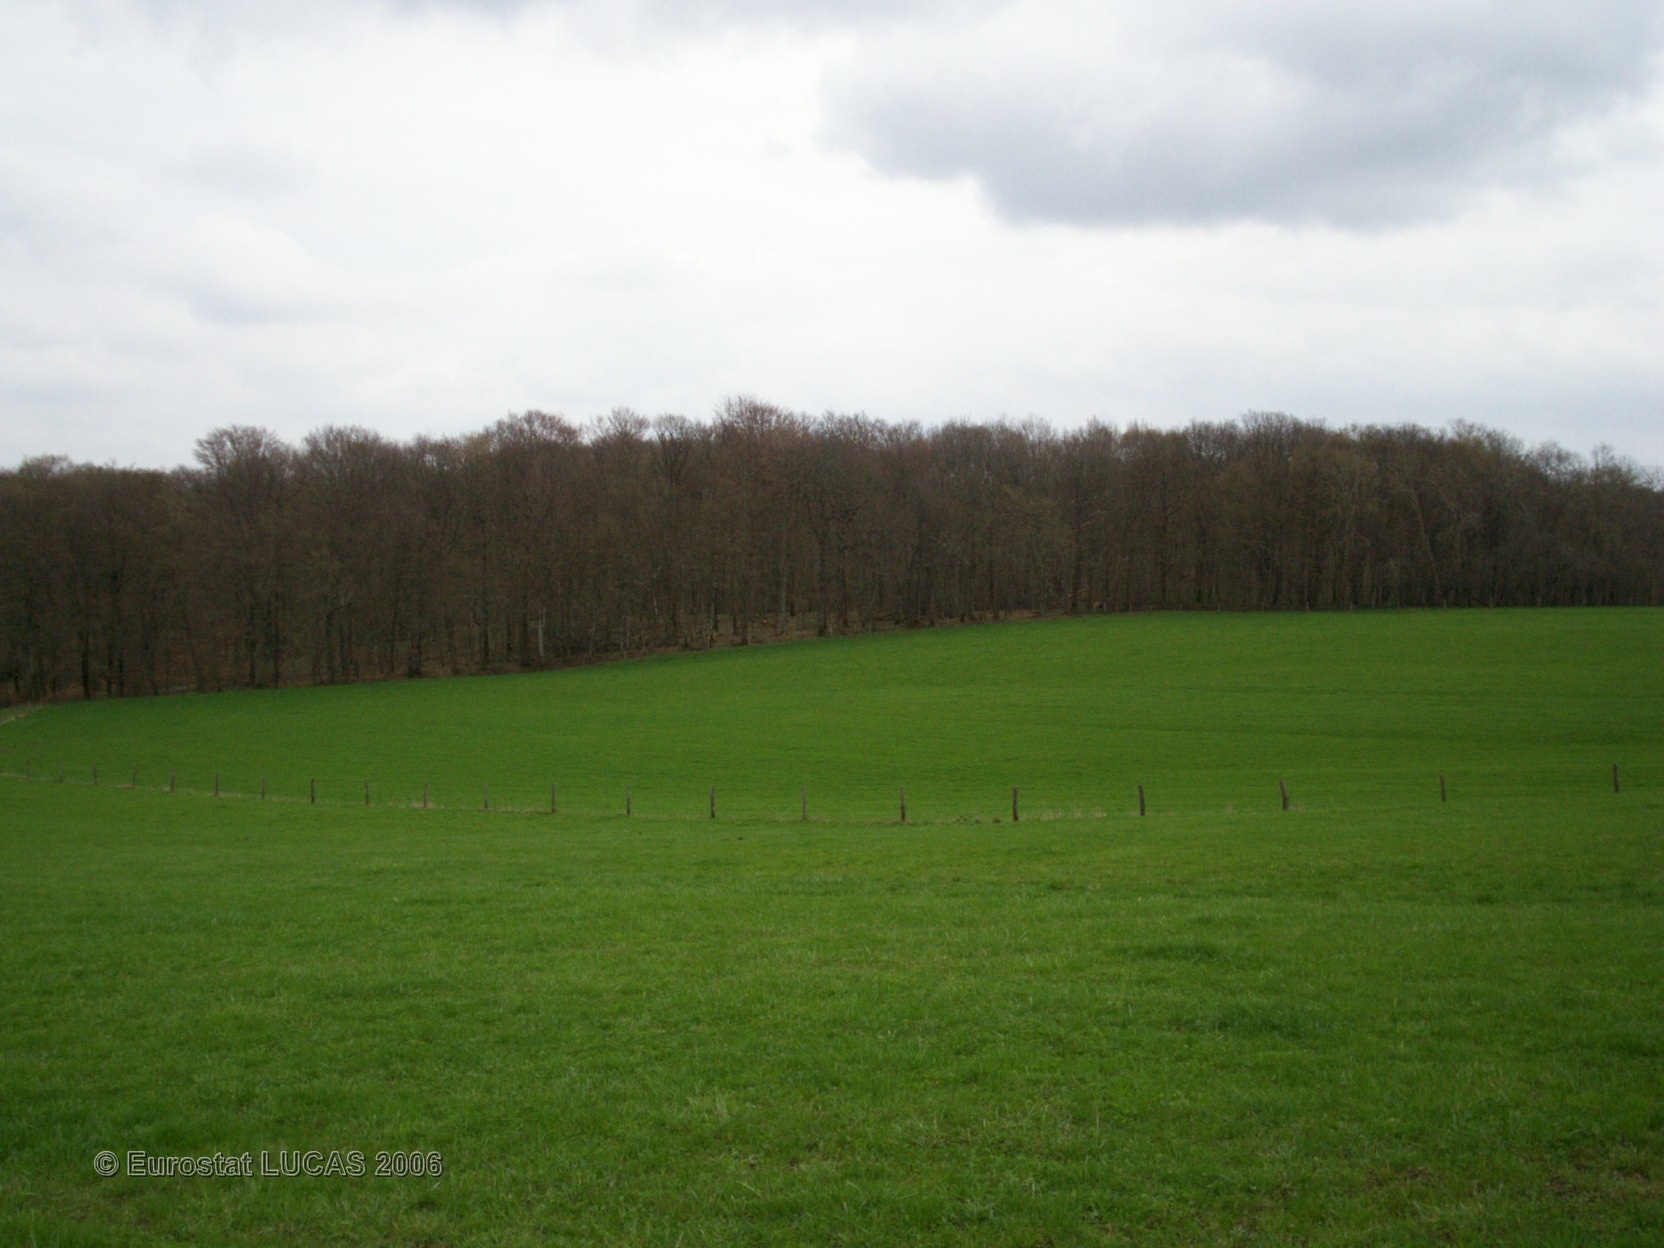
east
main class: Grassland
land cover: Grassland without tree/shrub cover
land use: Agriculture (excluding fallow land and kitchen gardens)
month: April
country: FR
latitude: 48.2411
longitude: 6.0011
